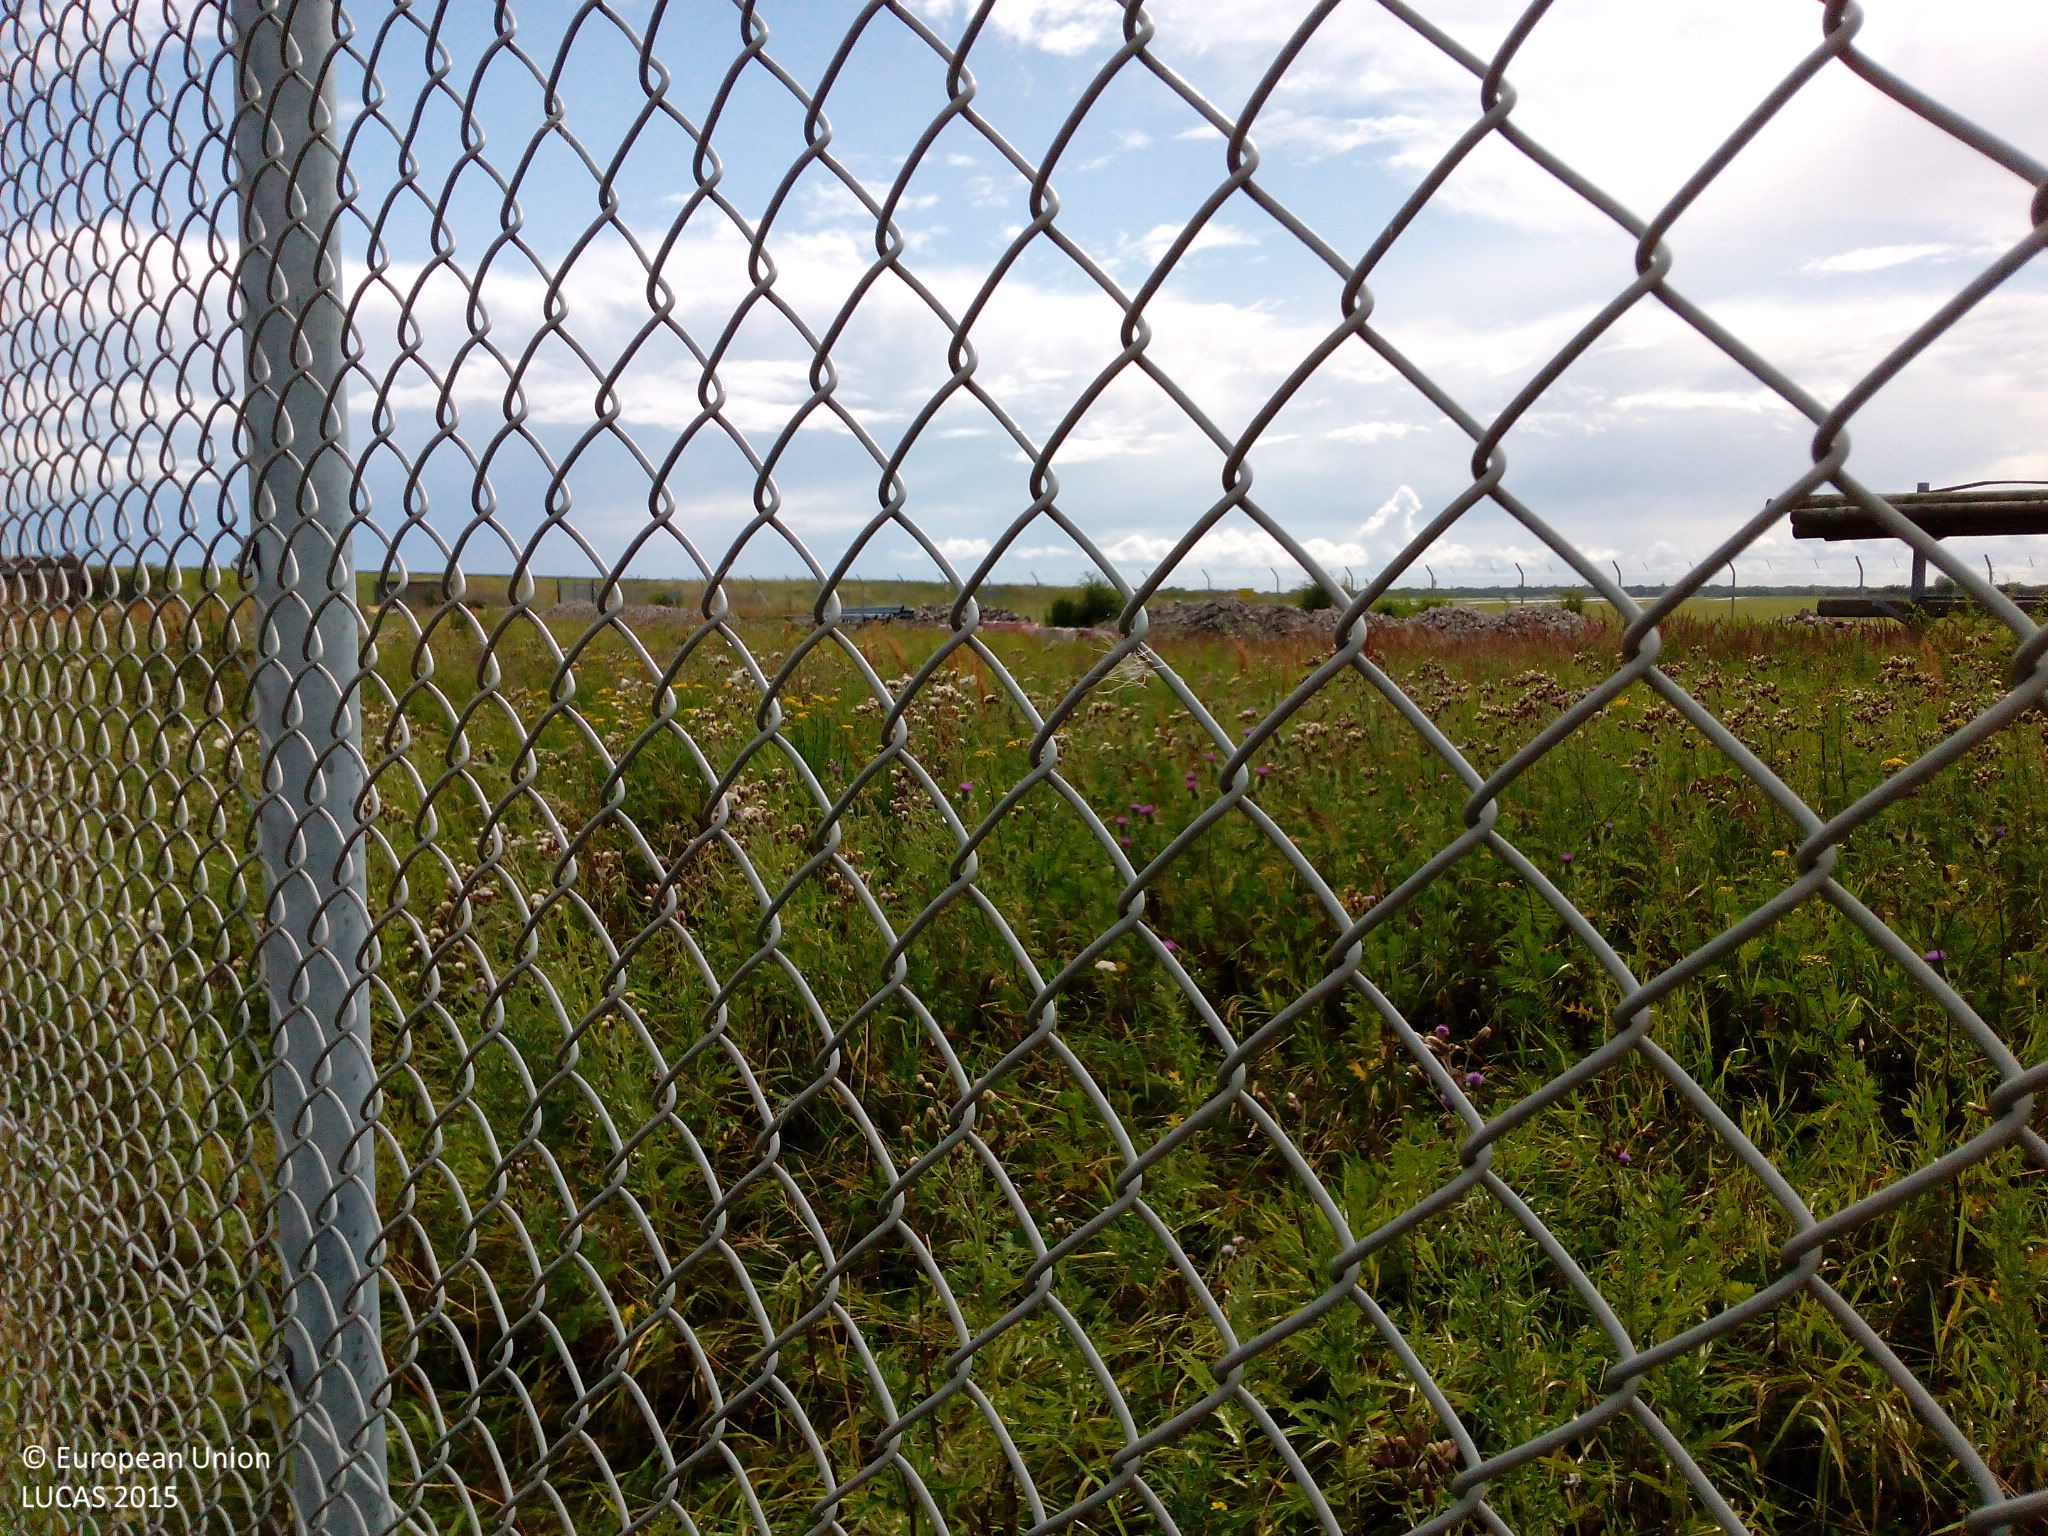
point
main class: Grassland
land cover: Grassland without tree/shrub cover
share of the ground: > 75 %
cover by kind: herbaceous plants 100 %
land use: Air transport
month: July
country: DK
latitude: 55.6036
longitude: 12.6170
